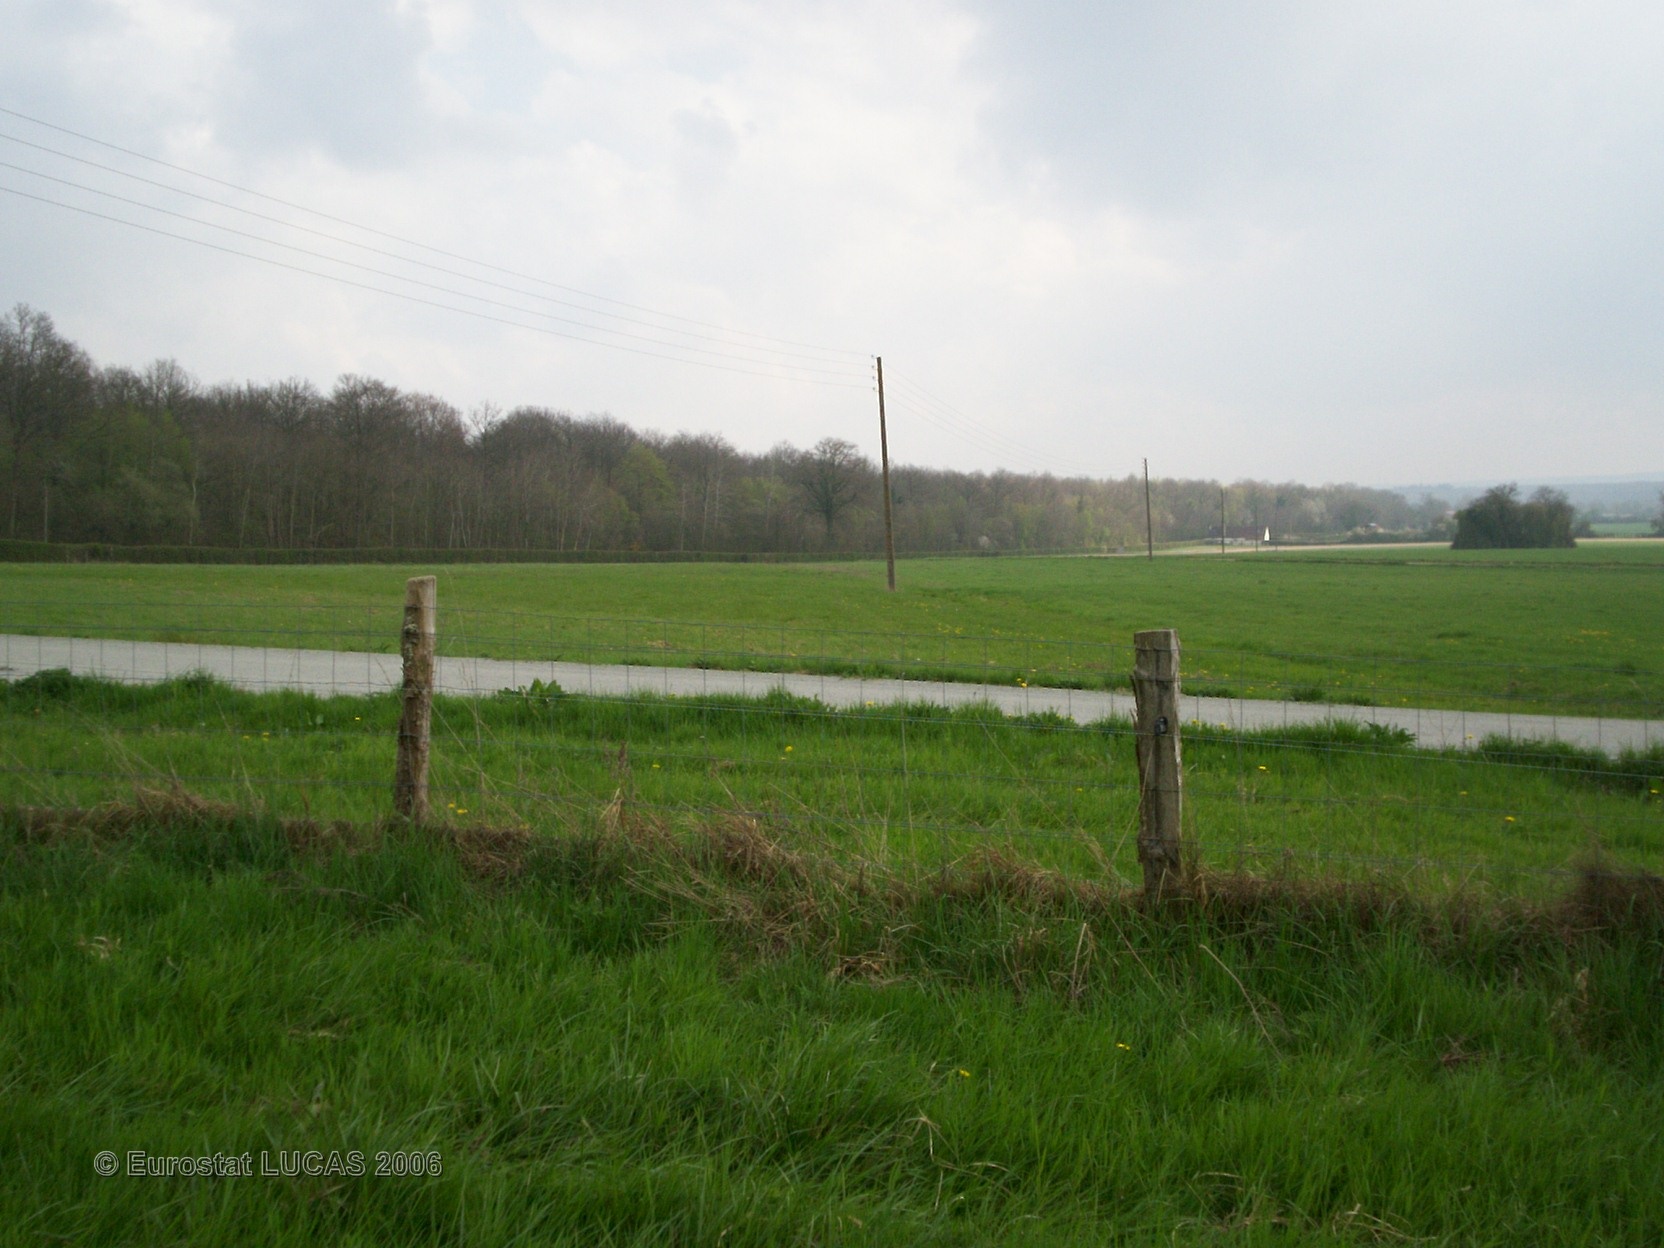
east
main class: Grassland
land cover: Grassland without tree/shrub cover
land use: Agriculture (excluding fallow land and kitchen gardens)
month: April
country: FR
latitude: 48.7055
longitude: 0.1467
